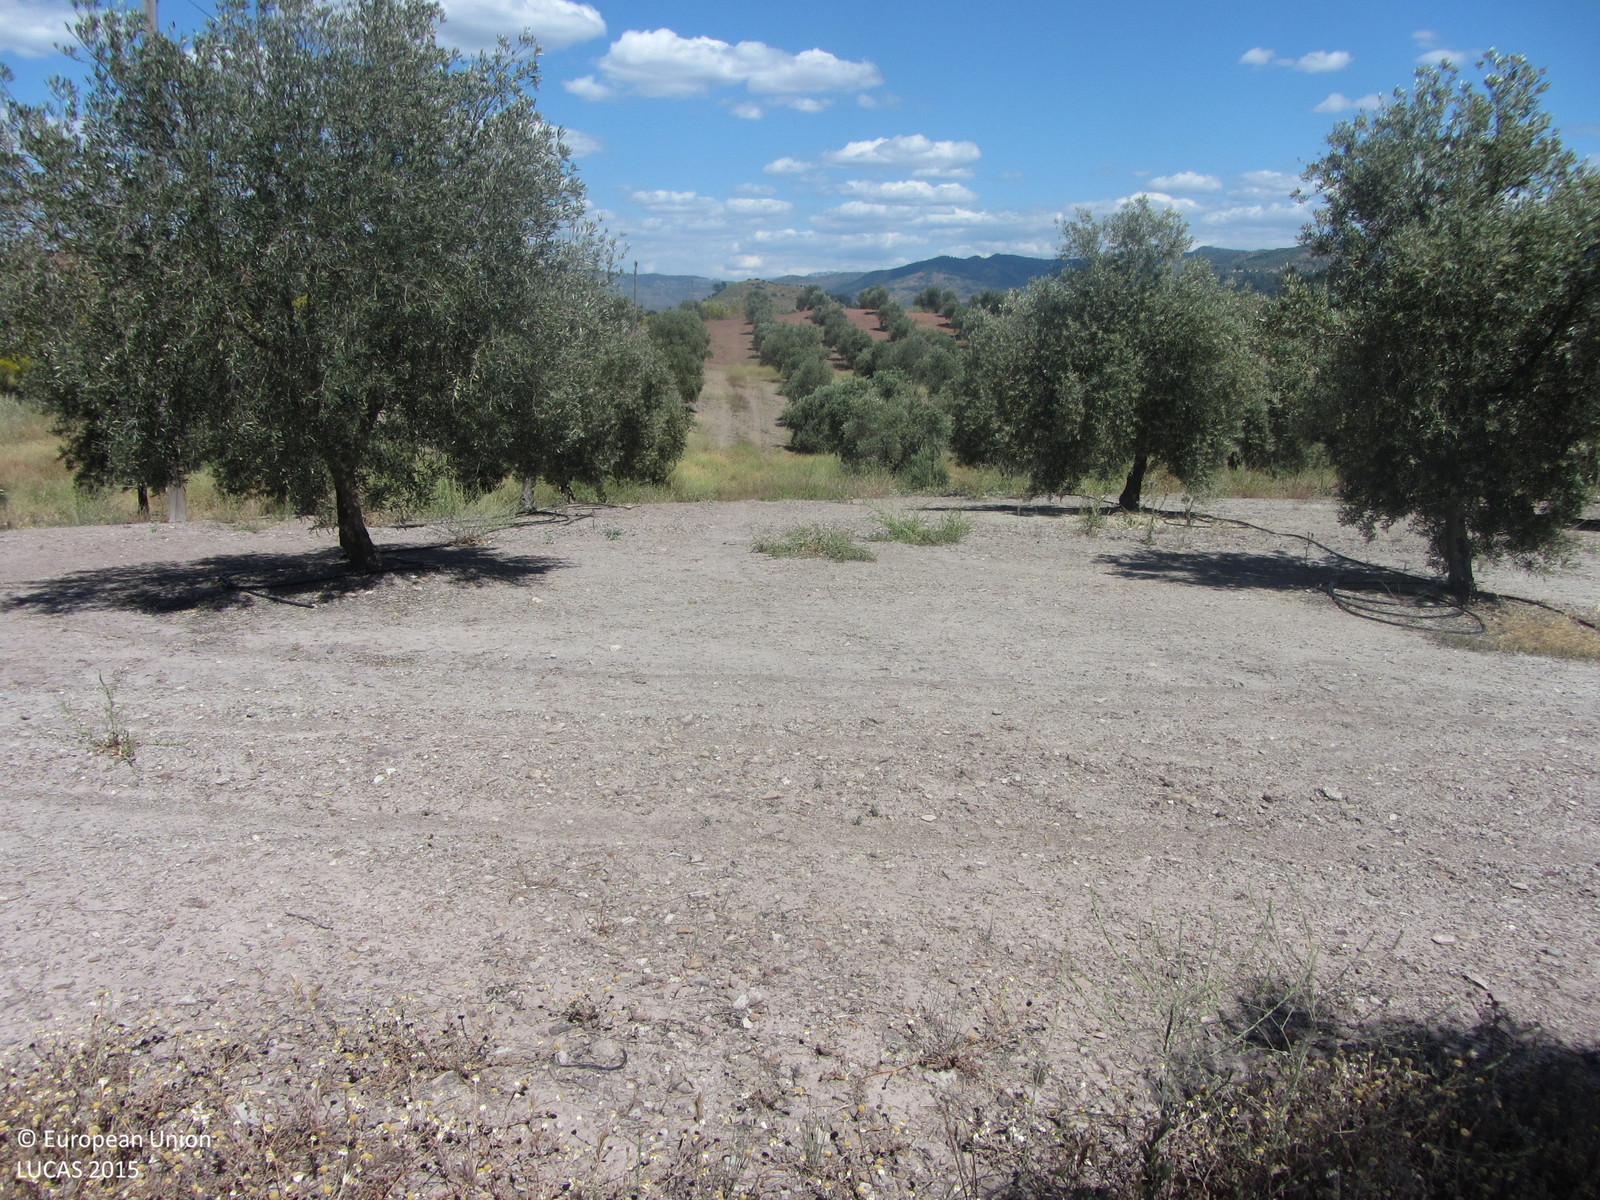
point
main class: Cropland
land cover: Olive groves
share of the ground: 25 - 50 %
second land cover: Other bare soil
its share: > 75 %
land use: Agriculture (excluding fallow land and kitchen gardens)
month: May
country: ES
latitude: 38.3534
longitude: -2.8738
